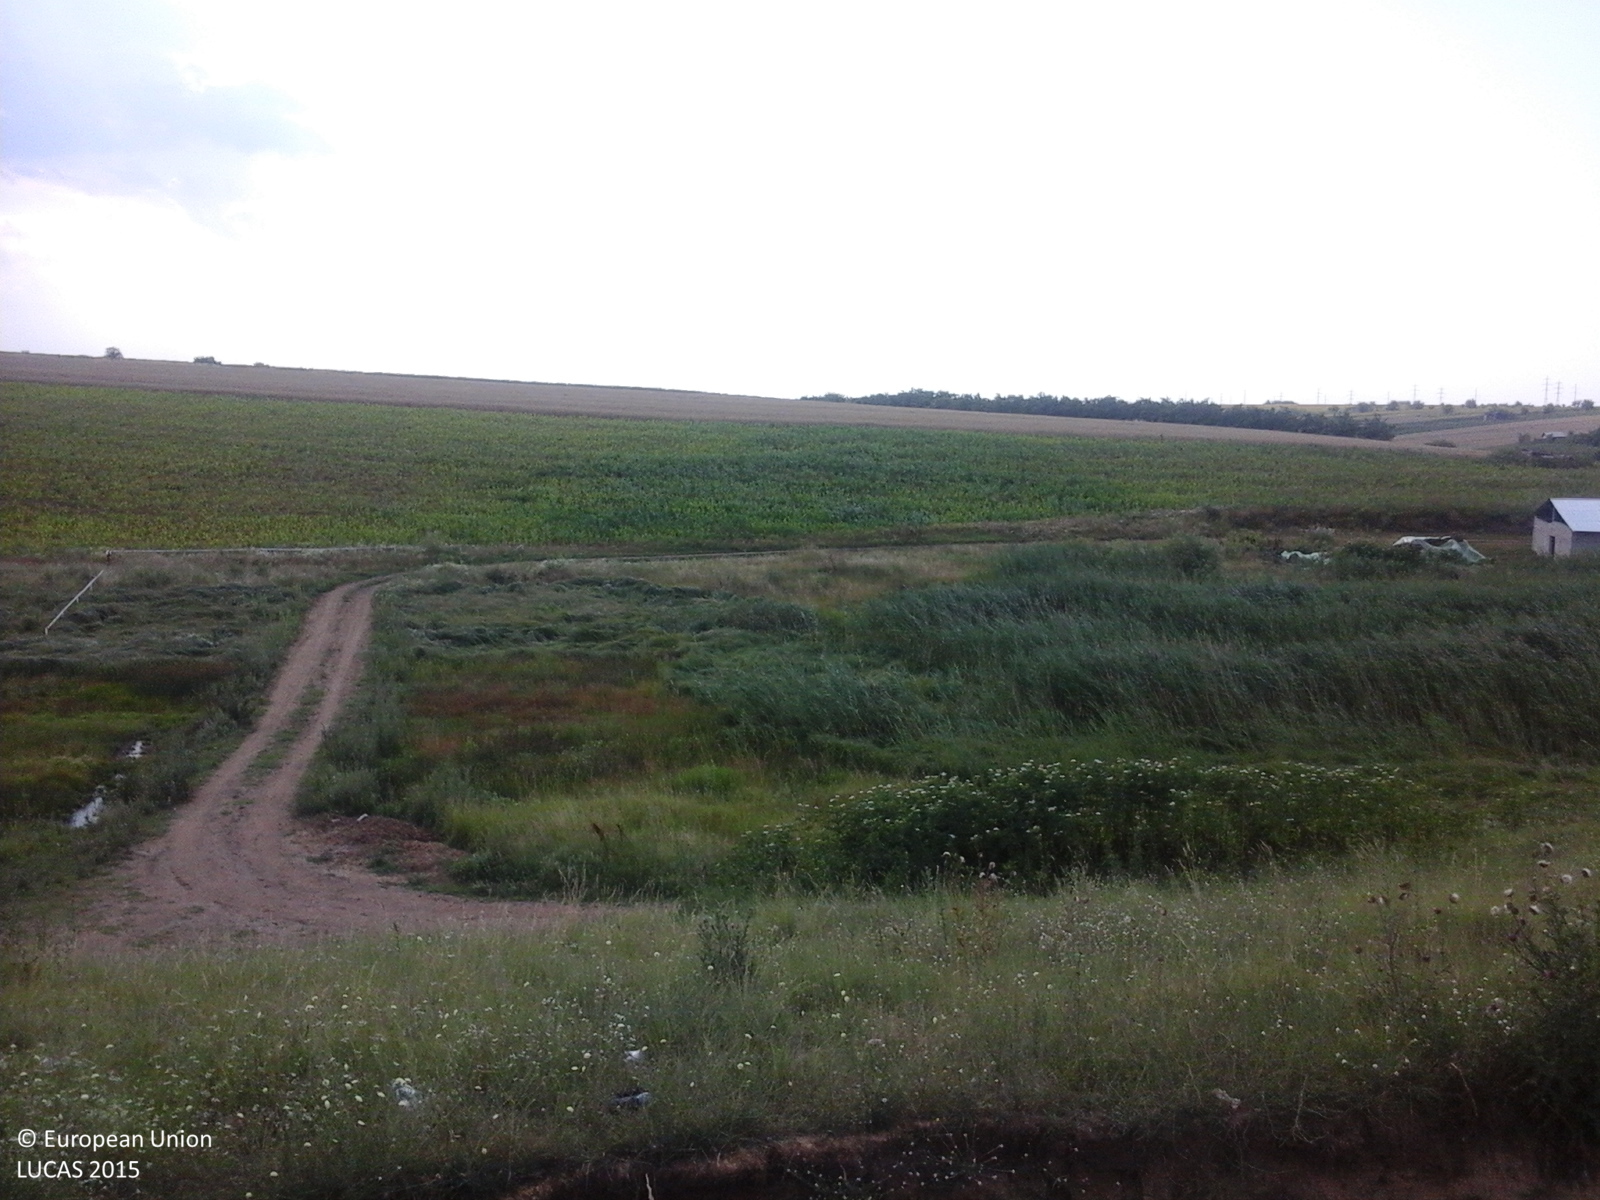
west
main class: Grassland
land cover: Spontaneously vegetated surfaces
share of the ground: > 75 %
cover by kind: herbaceous plants 100 %
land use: Fallow land
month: July
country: RO
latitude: 43.9385
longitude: 25.3184
